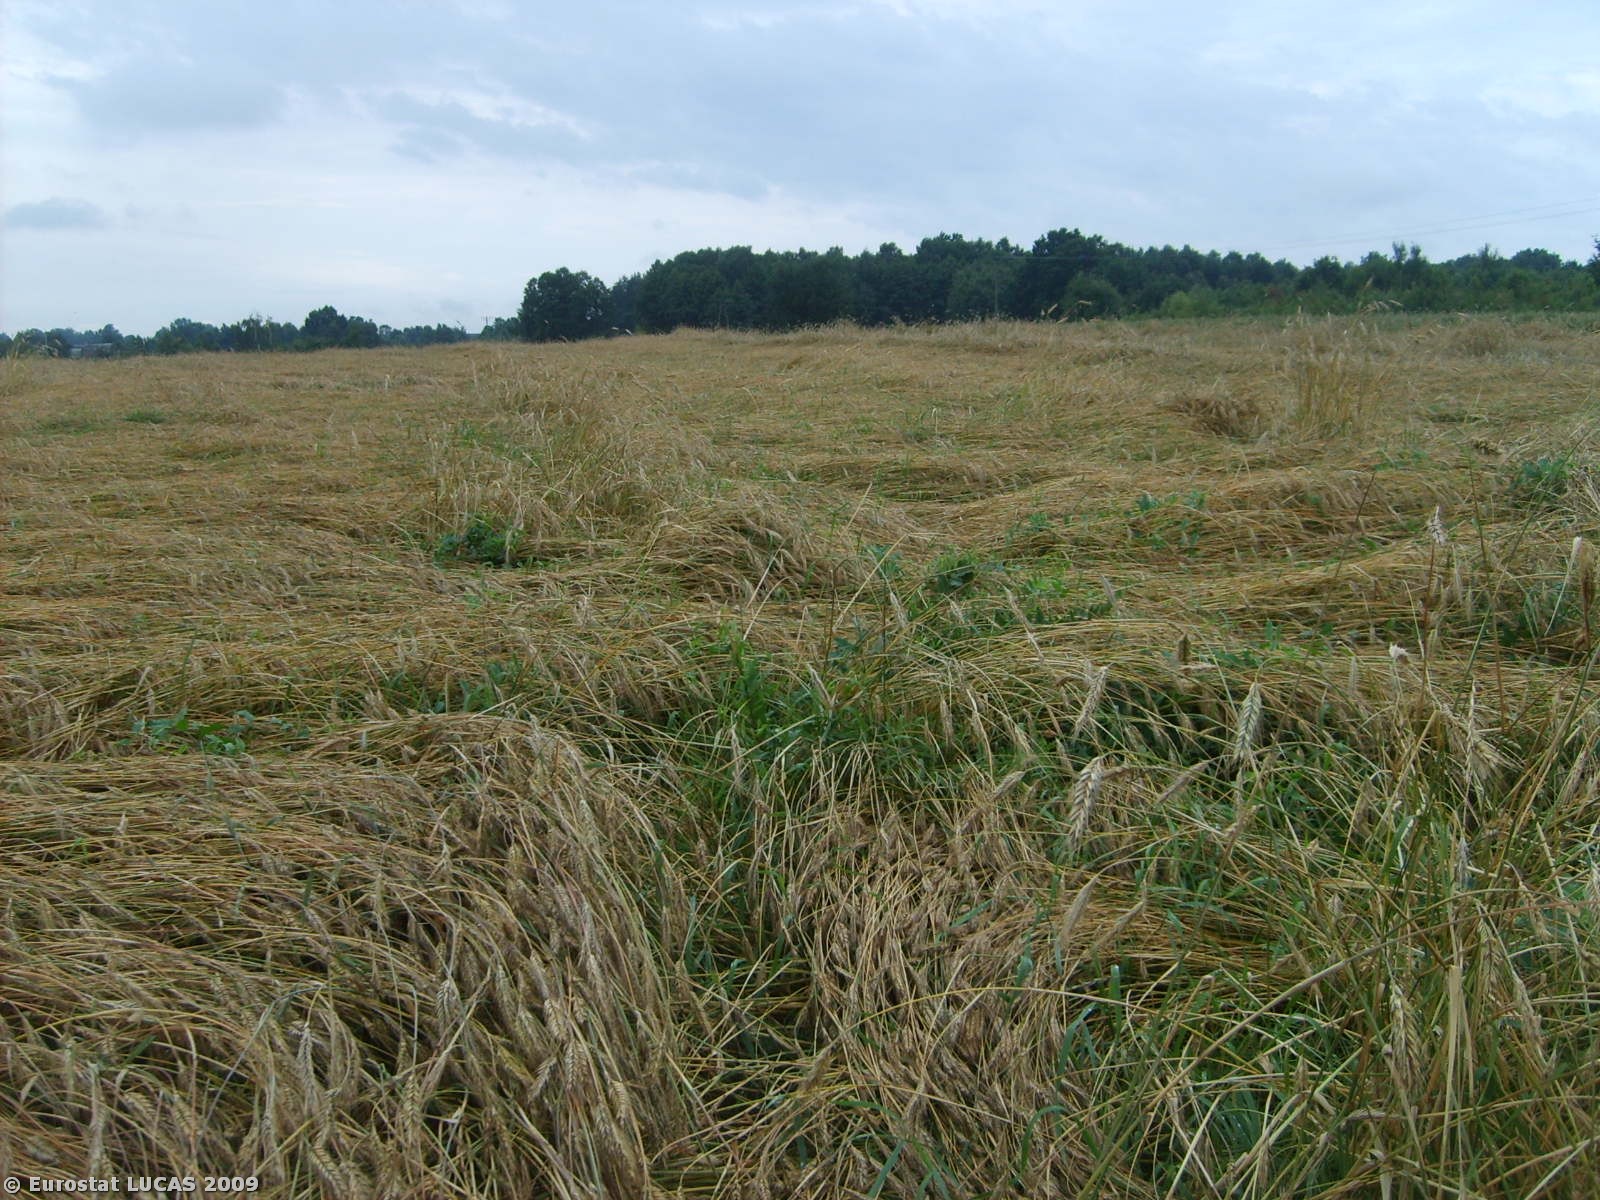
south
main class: Cropland
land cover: Rye
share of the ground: > 75 %
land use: Agriculture (excluding fallow land and kitchen gardens)
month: July
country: PL
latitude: 52.2893
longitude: 21.6795
